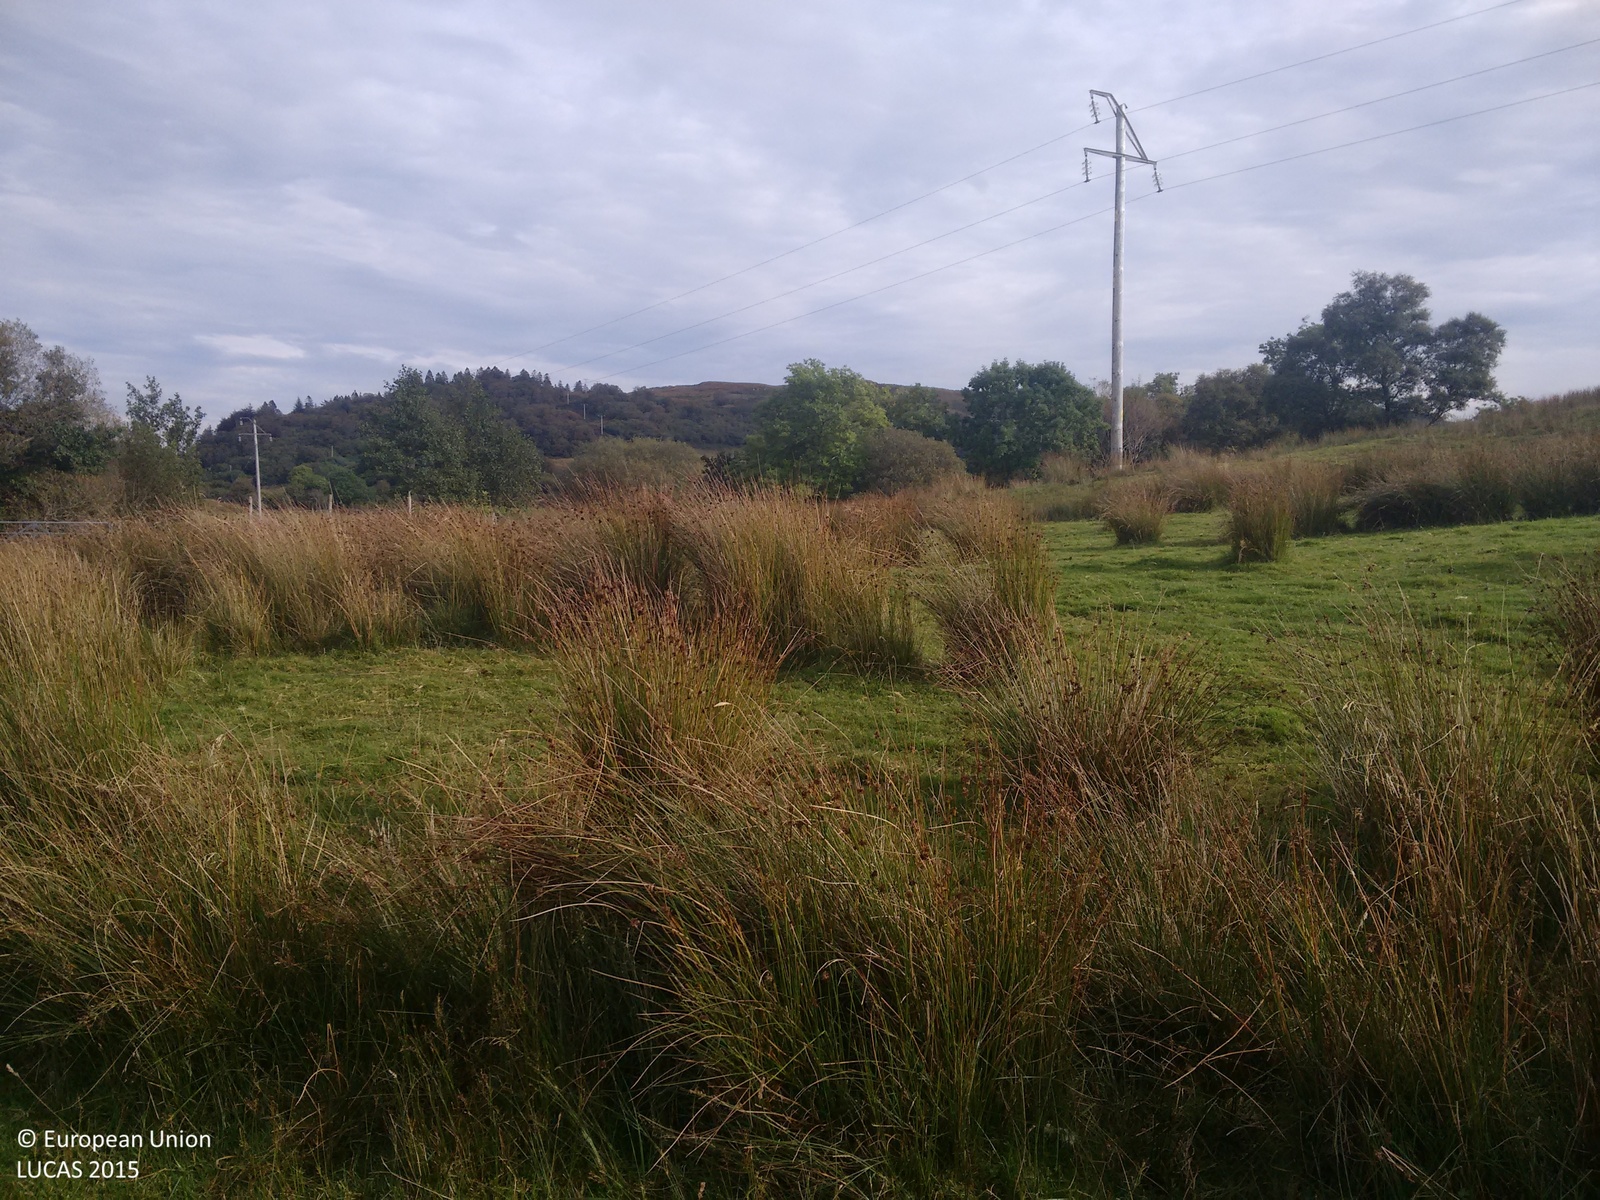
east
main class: Grassland
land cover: Grassland without tree/shrub cover
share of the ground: > 75 %
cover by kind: herbaceous plants 95 %, shrubs 5 %
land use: Agriculture (excluding fallow land and kitchen gardens)
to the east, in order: Grassland without tree/shrub cover; Fences; Broadleaved woodland; Grass margins; Inland fresh running water; Grassland without tree/shrub cover; Fences; Grassland without tree/shrub cover; Electric lines; Grassland without tree/shrub cover; Fences; Broadleaved woodland; Fences; Grassland without tree/shrub cover
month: September
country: GB
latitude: 56.4059
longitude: -5.3995
